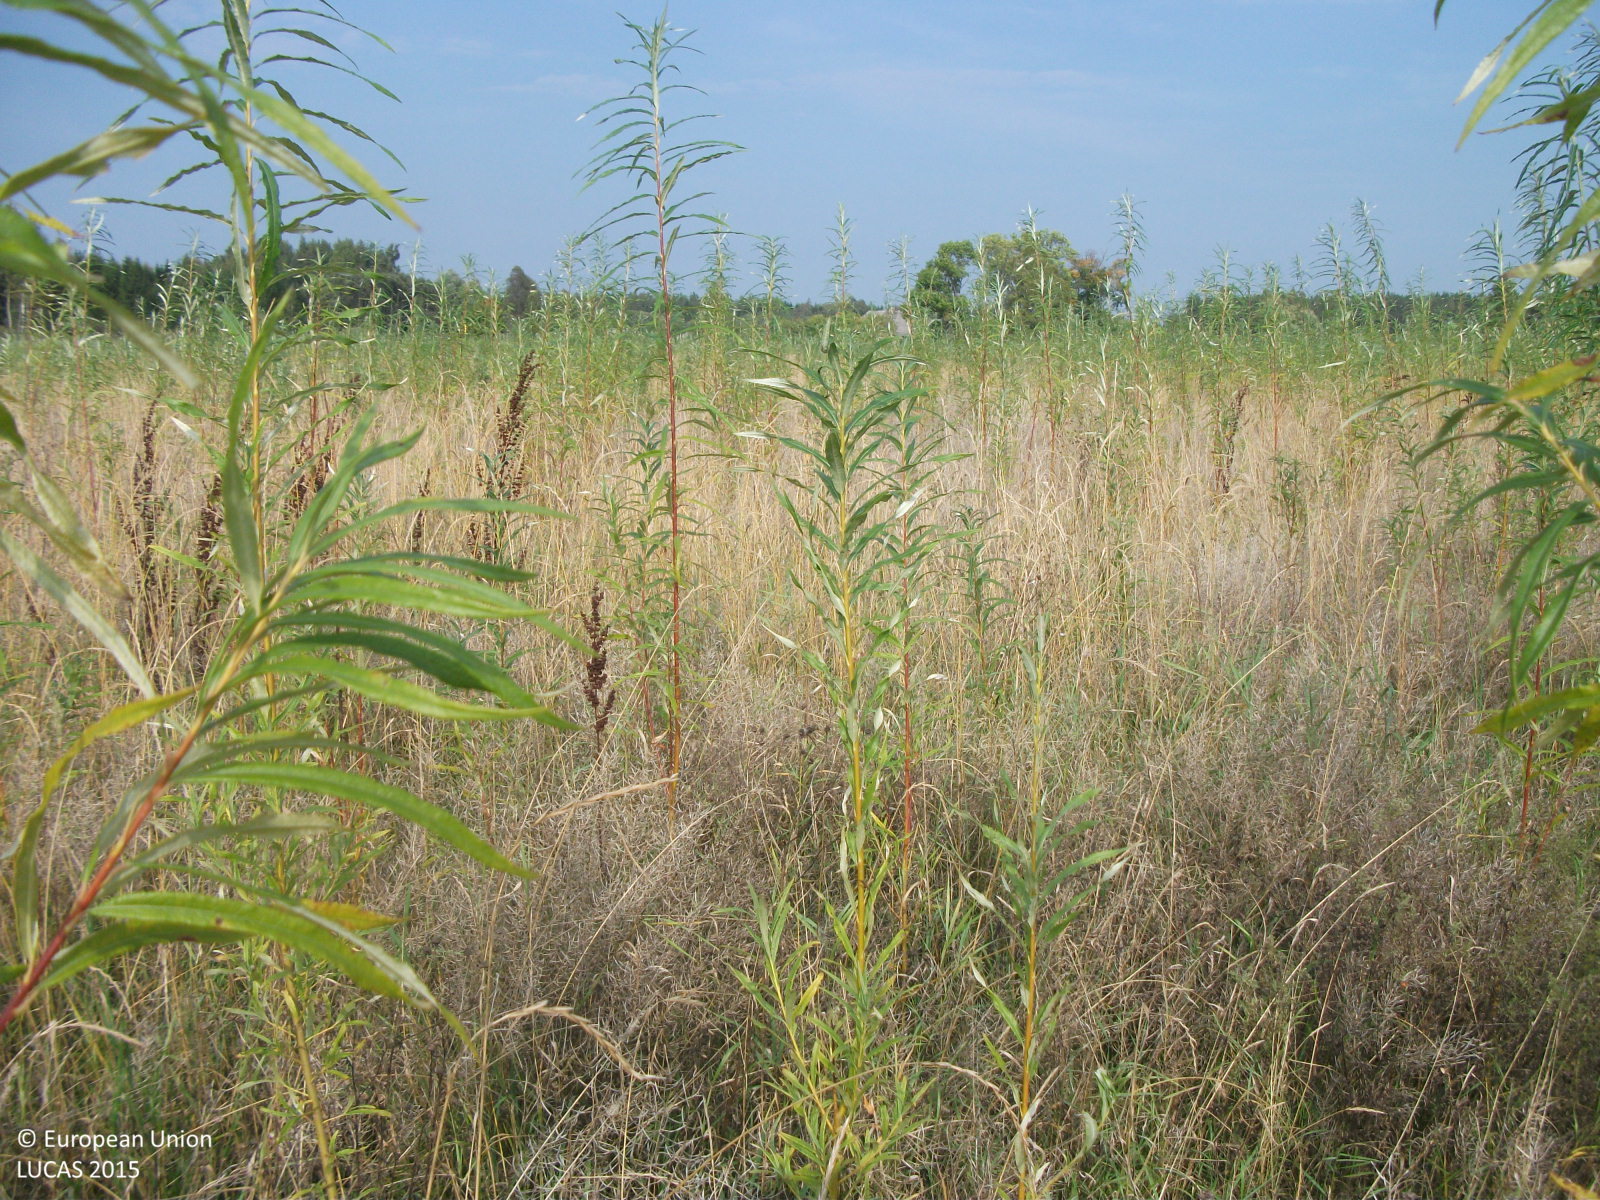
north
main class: Cropland
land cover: Permanent industrial crops
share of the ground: 25 - 50 %
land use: Agriculture (excluding fallow land and kitchen gardens)
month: September
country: LV
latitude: 57.7754
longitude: 24.4991
